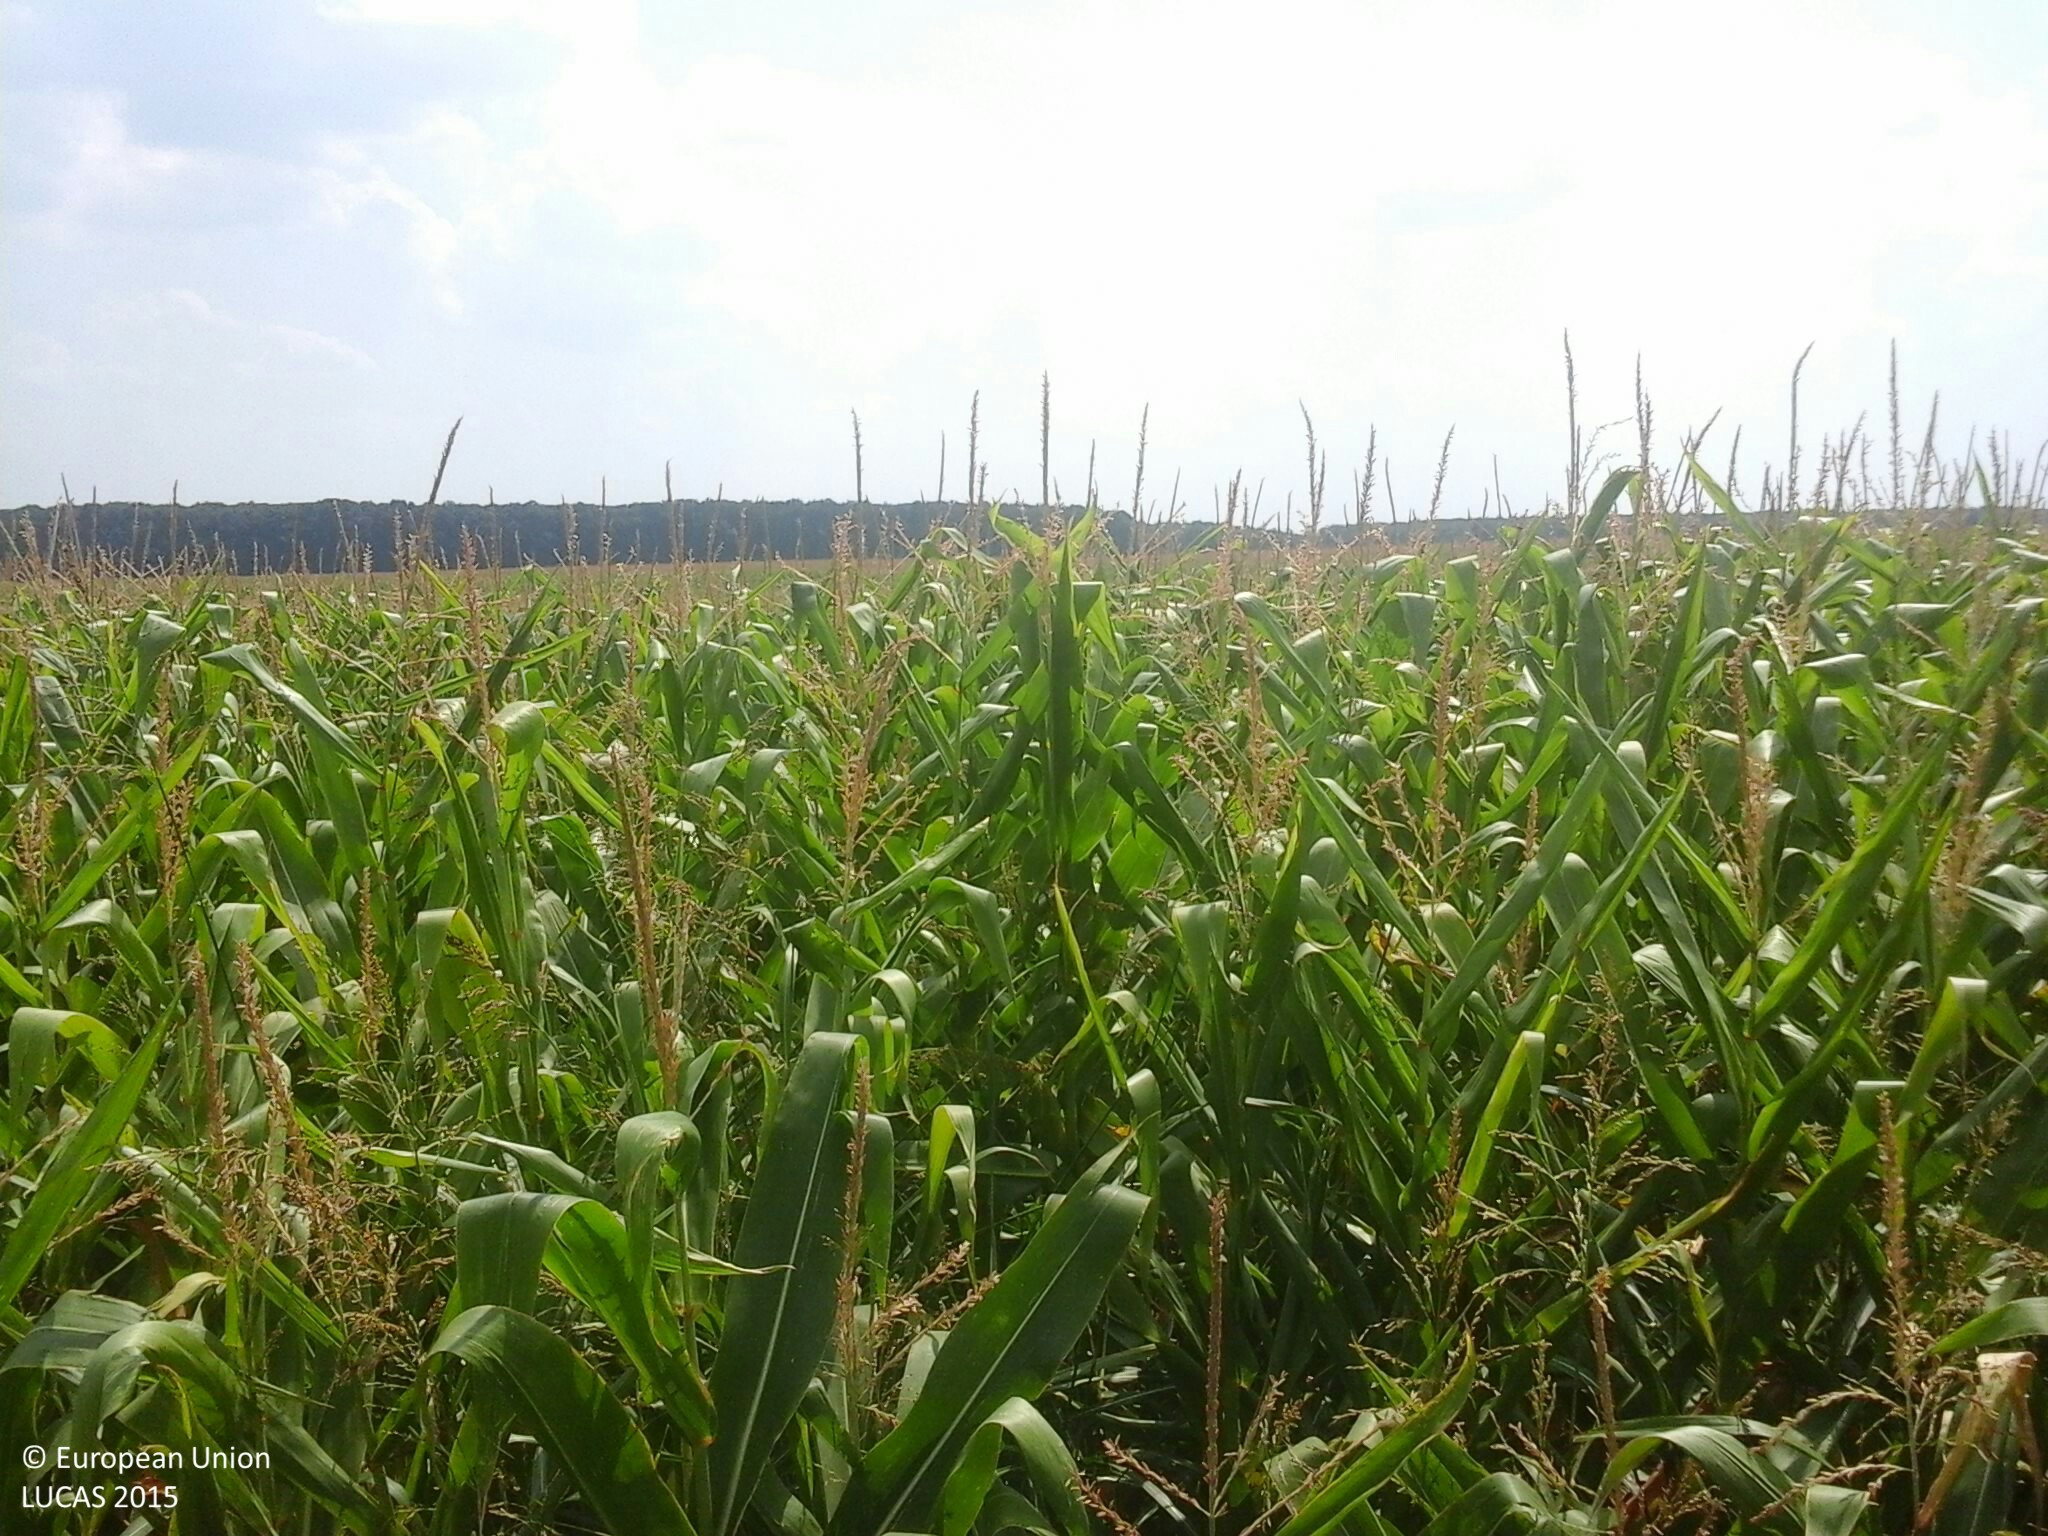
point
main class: Cropland
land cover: Maize
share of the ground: > 75 %
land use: Agriculture (excluding fallow land and kitchen gardens)
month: August
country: HU
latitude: 45.9675
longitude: 18.1493
